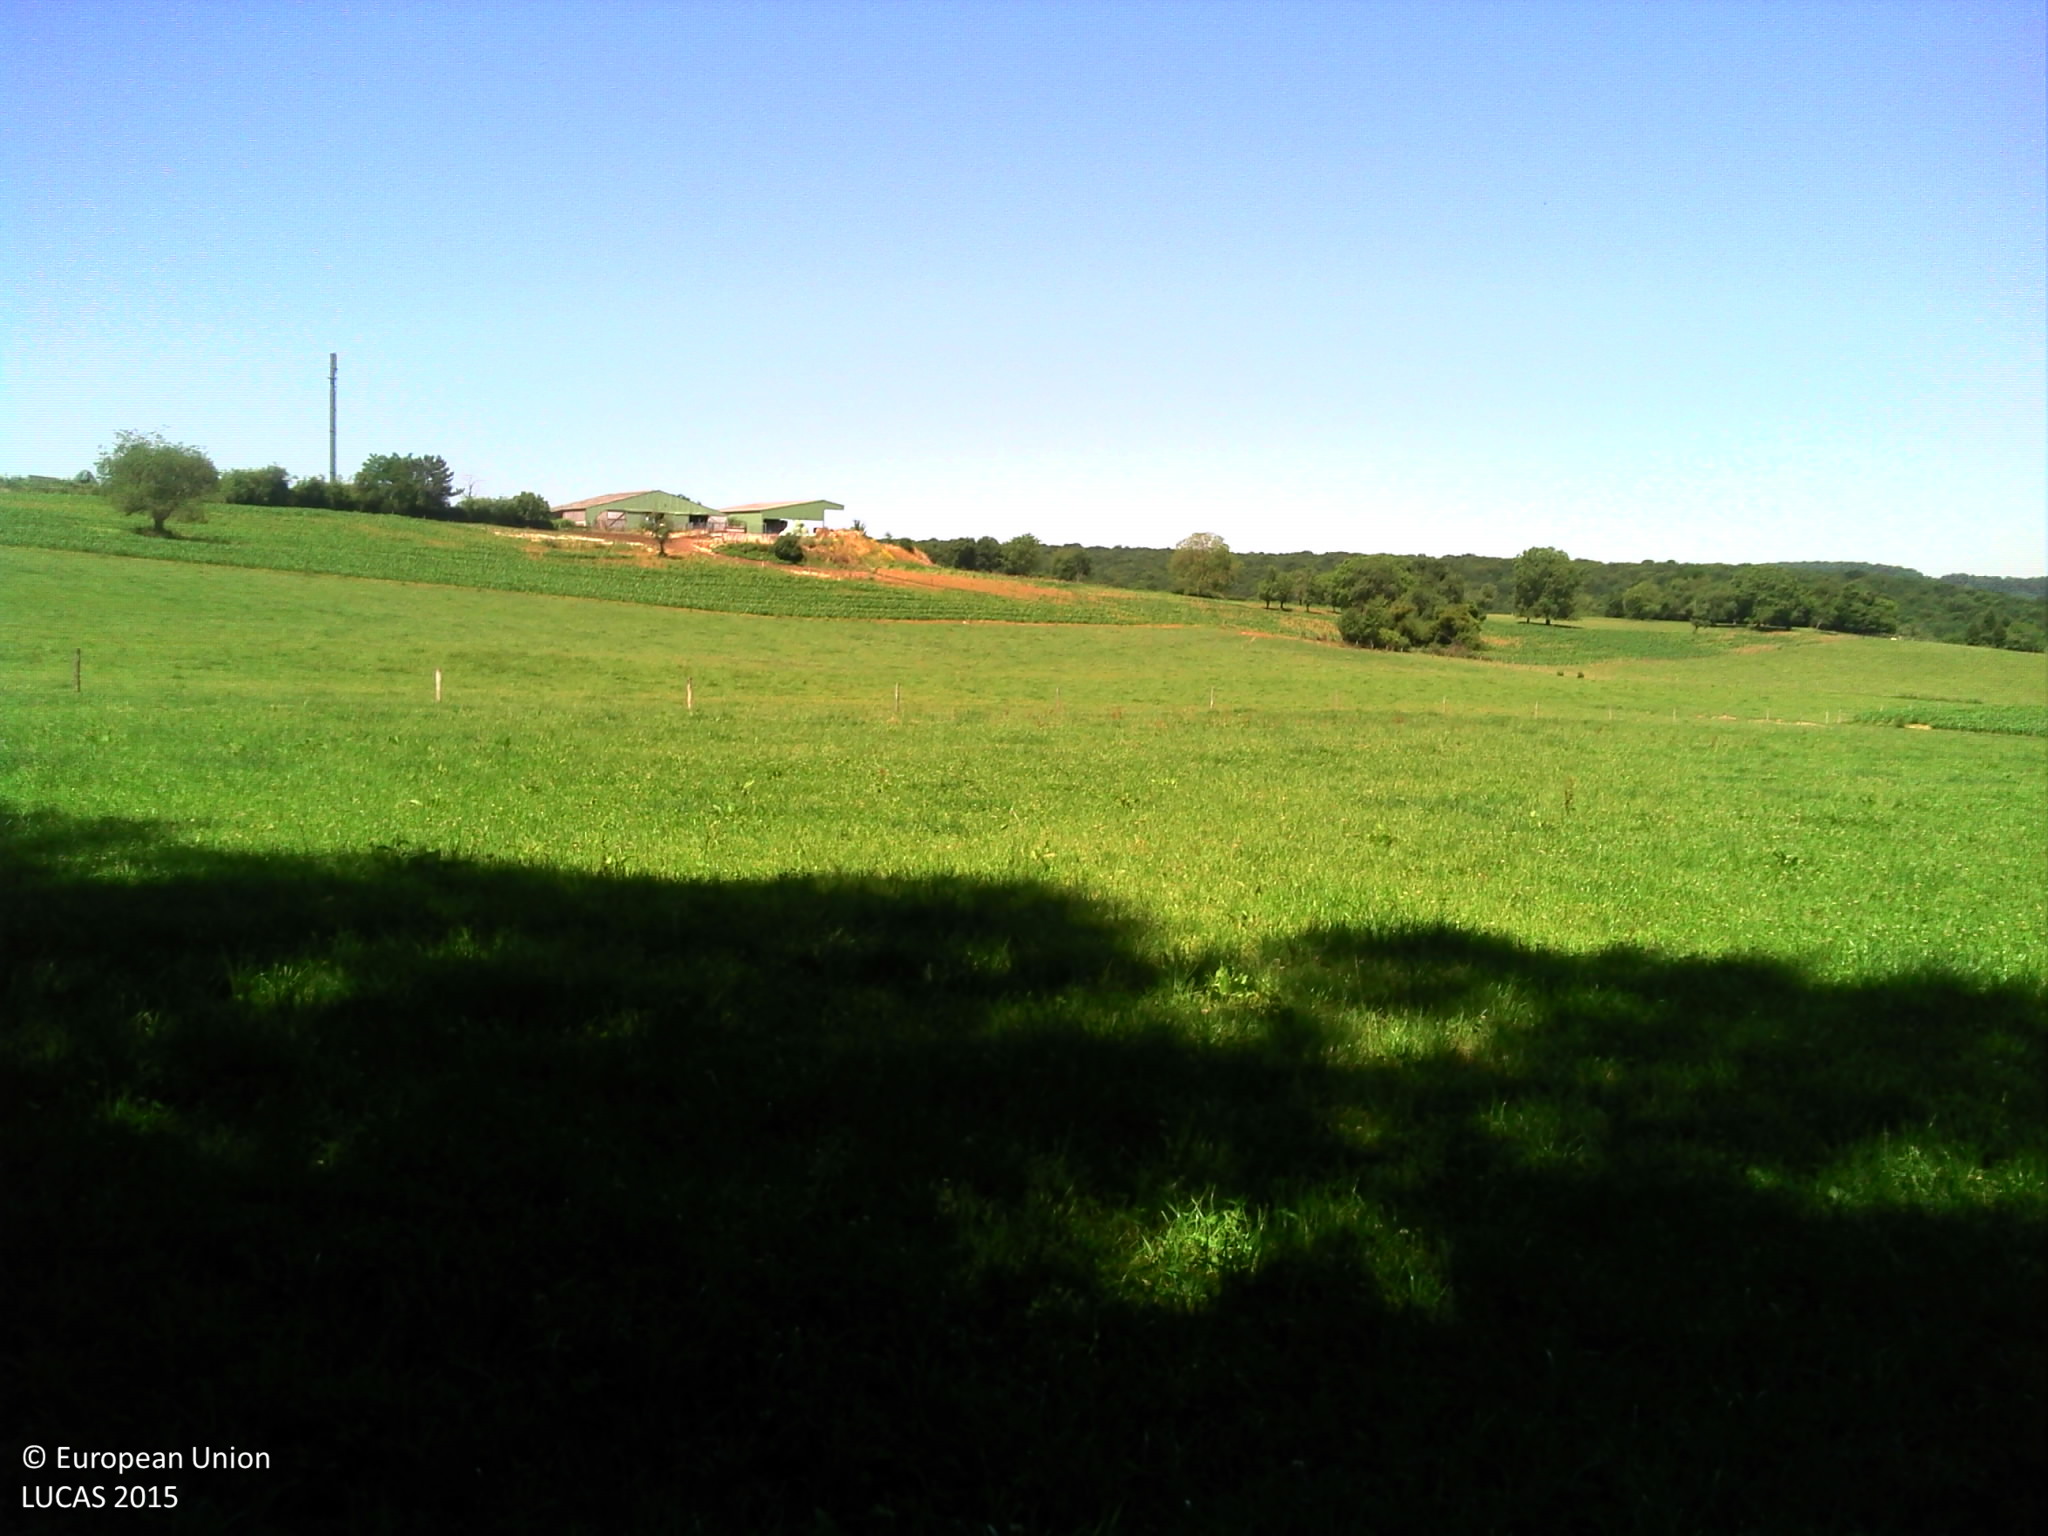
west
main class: Cropland
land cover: Temporary grasslands
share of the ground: > 75 %
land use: Agriculture (excluding fallow land and kitchen gardens)
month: June
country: FR
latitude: 47.4534
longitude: 6.1418
